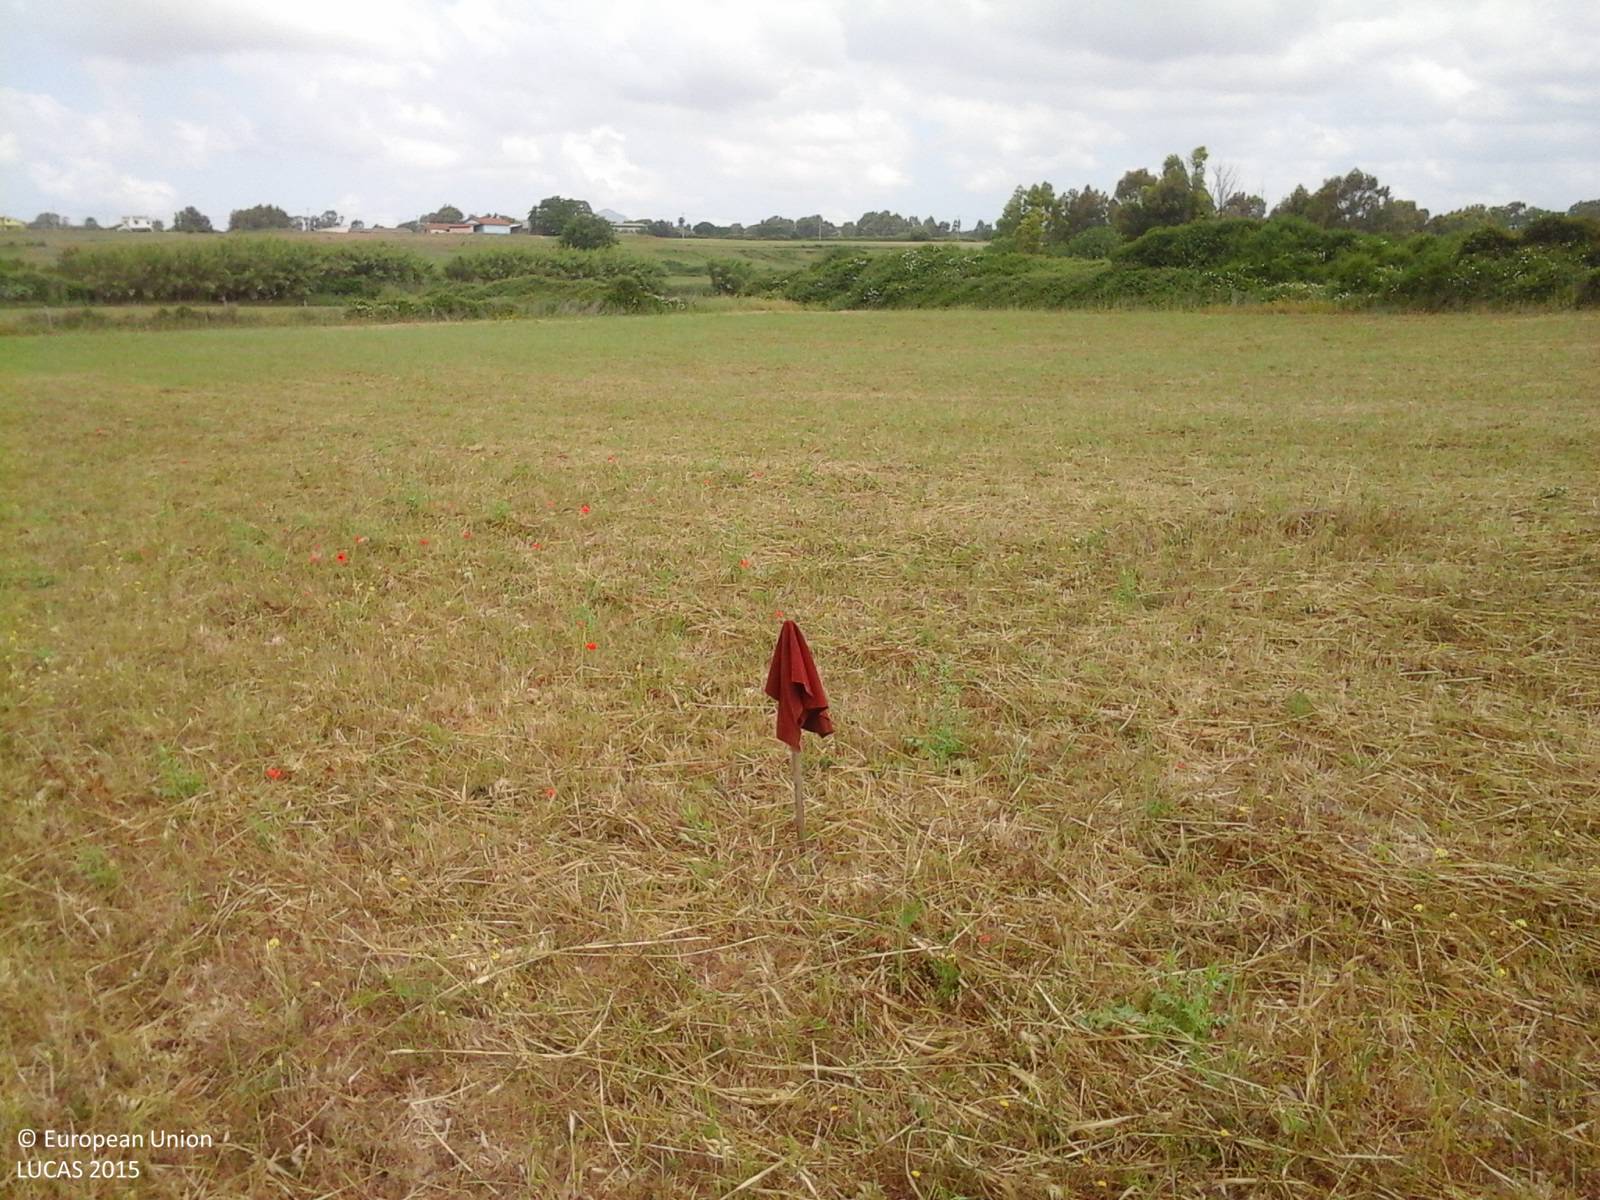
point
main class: Cropland
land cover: Mixed cereals for fodder
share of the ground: > 75 %
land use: Agriculture (excluding fallow land and kitchen gardens)
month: May
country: IT
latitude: 40.6519
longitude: 8.3641
